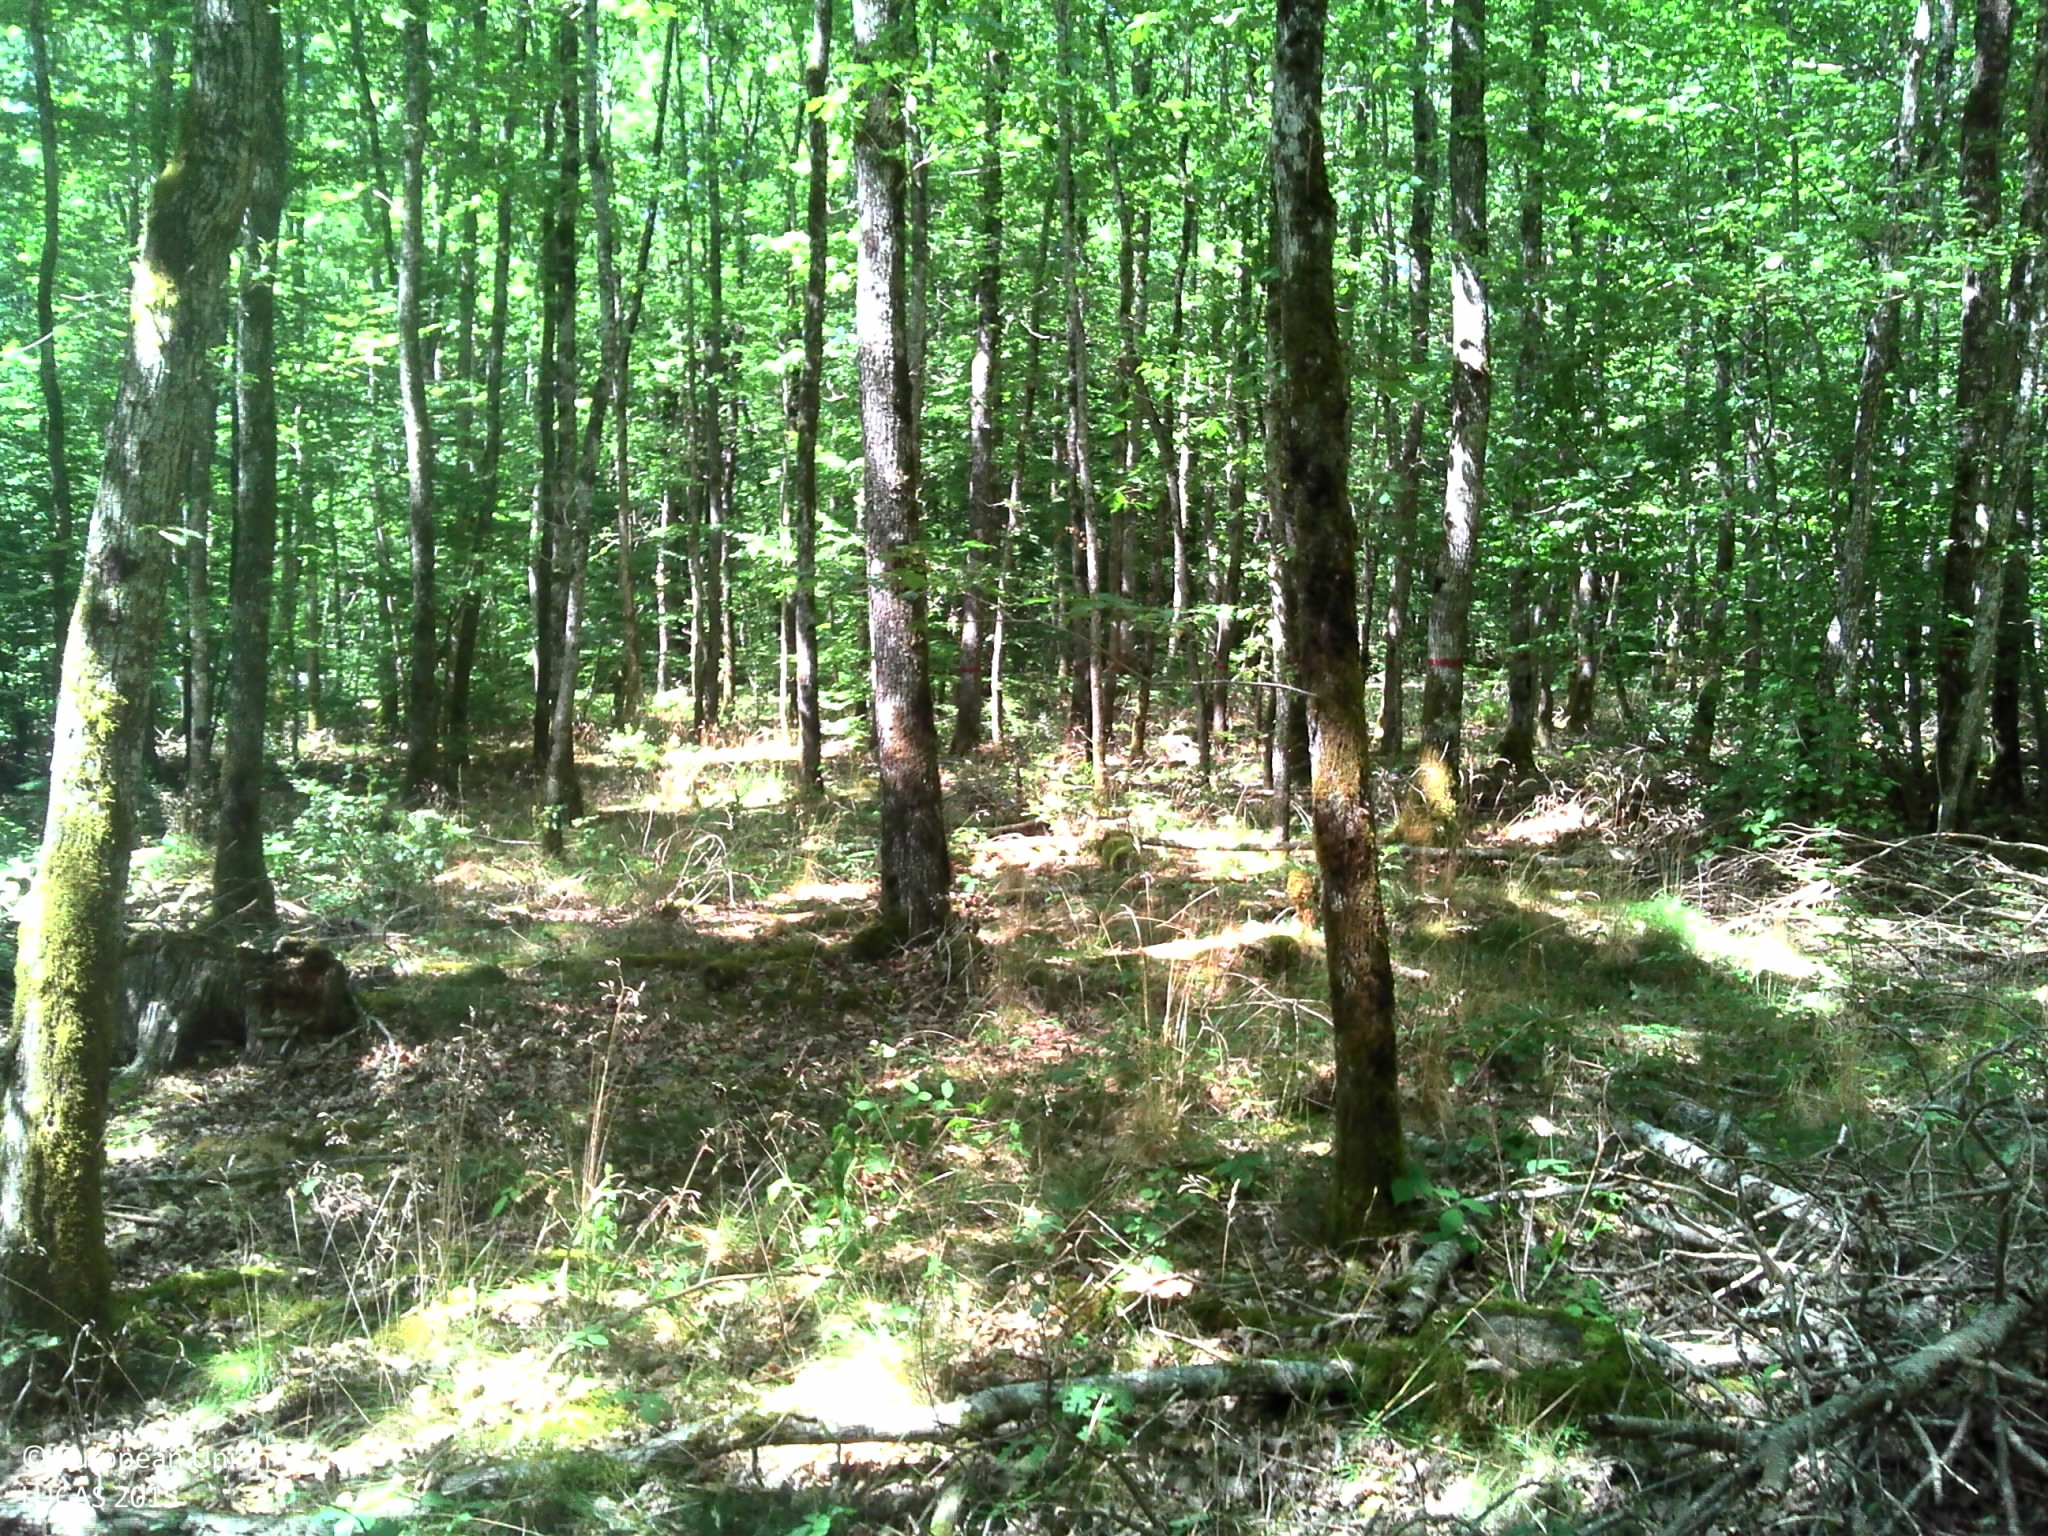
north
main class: Woodland
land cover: Broadleaved woodland
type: mesophytic deciduous forest
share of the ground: > 75 %
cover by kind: broadleaved forest trees 100 %
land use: Forestry
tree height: > 5 m
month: July
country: FR
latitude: 47.0948
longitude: 3.2378
